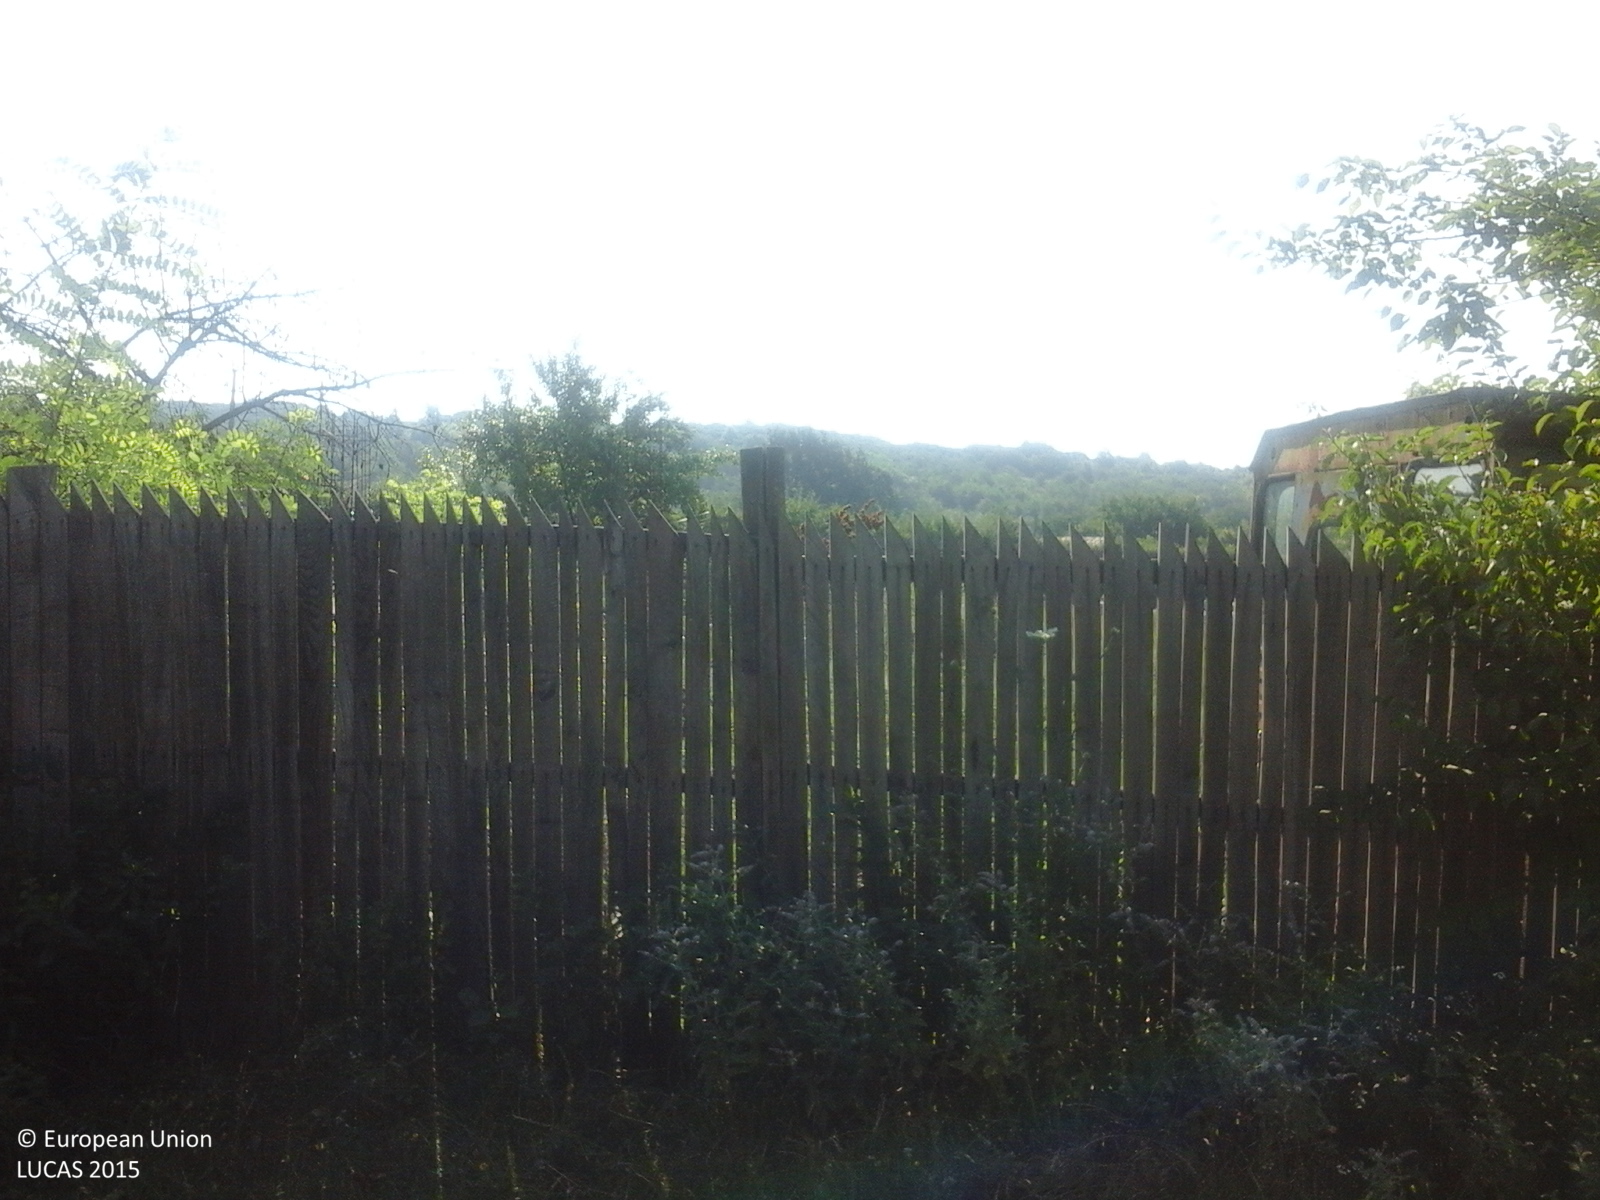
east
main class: Cropland
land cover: Common wheat
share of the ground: > 75 %
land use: Agriculture (excluding fallow land and kitchen gardens)
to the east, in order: Common wheat; Other fruit trees and berries; Permanent crops (only in case pi); Fences; Vineyards; Artificial constructions in urban areas; Other fruit trees and berries; Abandoned hedges; Permanent crops (only in case pi)
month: July
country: RO
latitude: 44.7547
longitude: 24.3575
